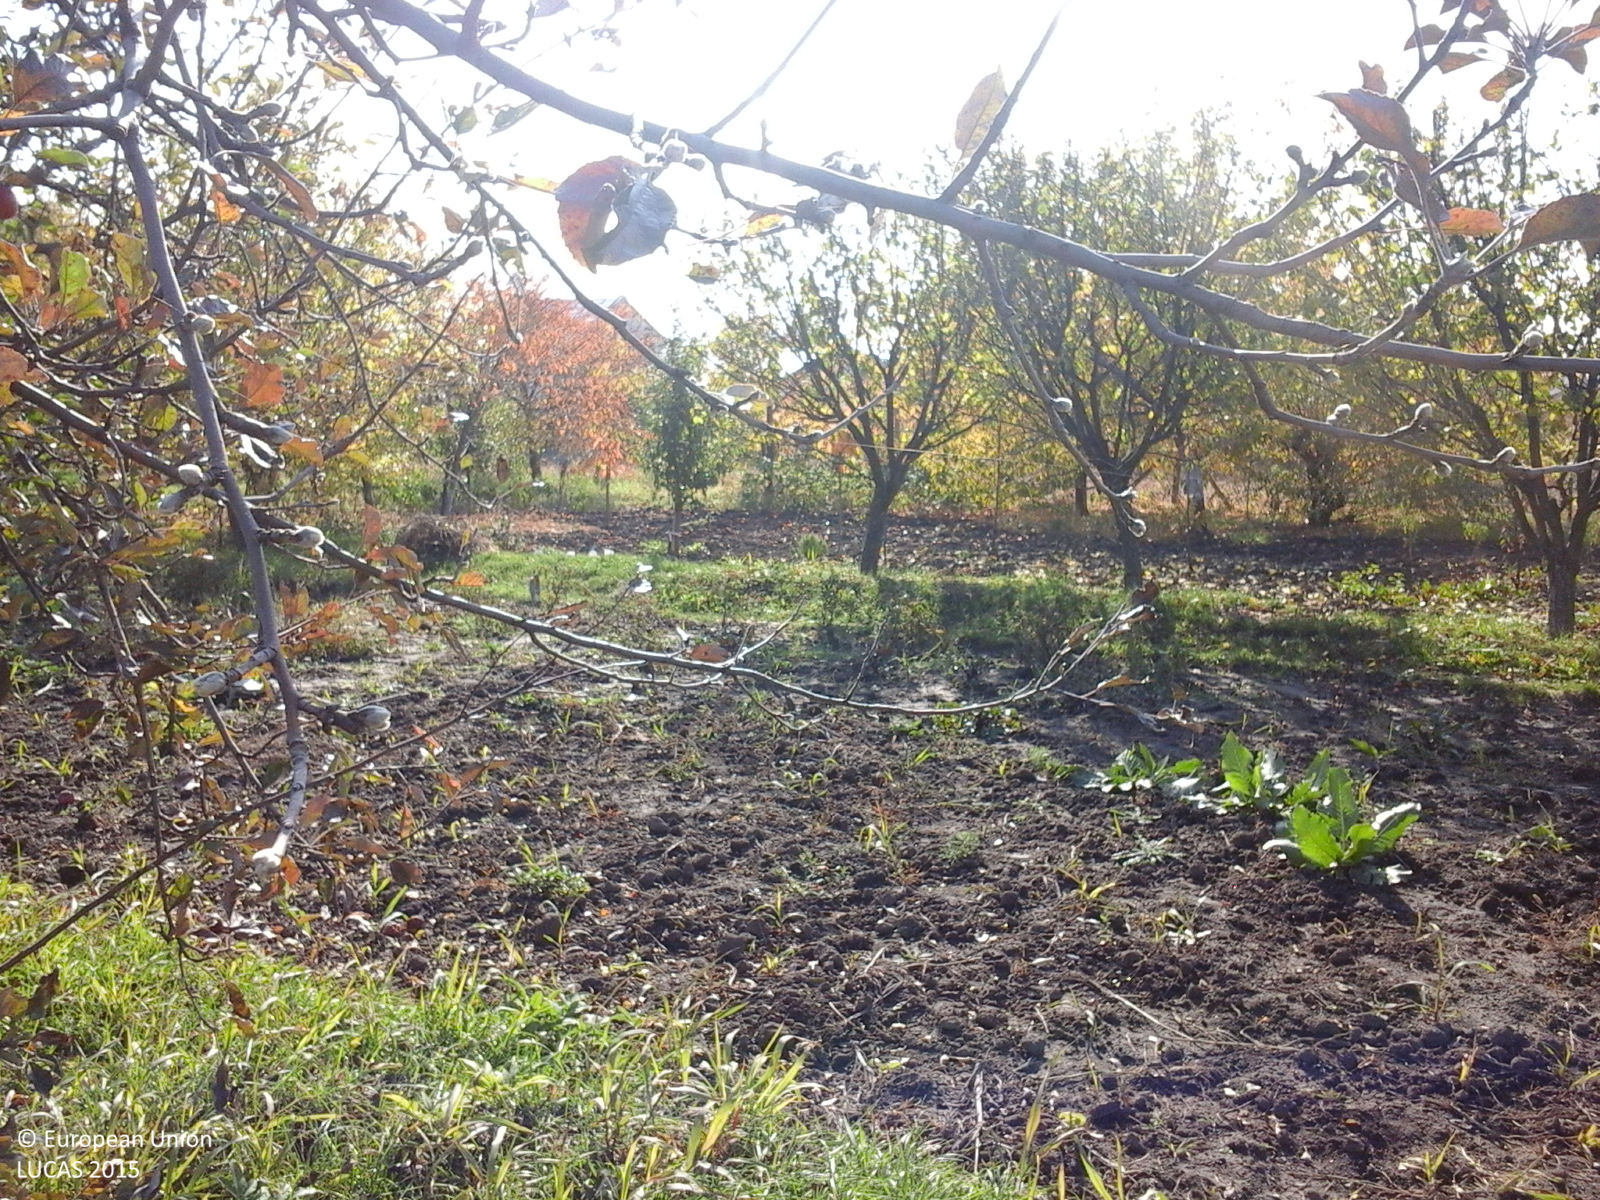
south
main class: Cropland
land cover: Apple fruit
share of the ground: 50 - 75 %
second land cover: Grassland without tree/shrub cover
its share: > 75 %
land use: Agriculture (excluding fallow land and kitchen gardens)
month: October
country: RO
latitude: 45.6039
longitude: 27.1056
